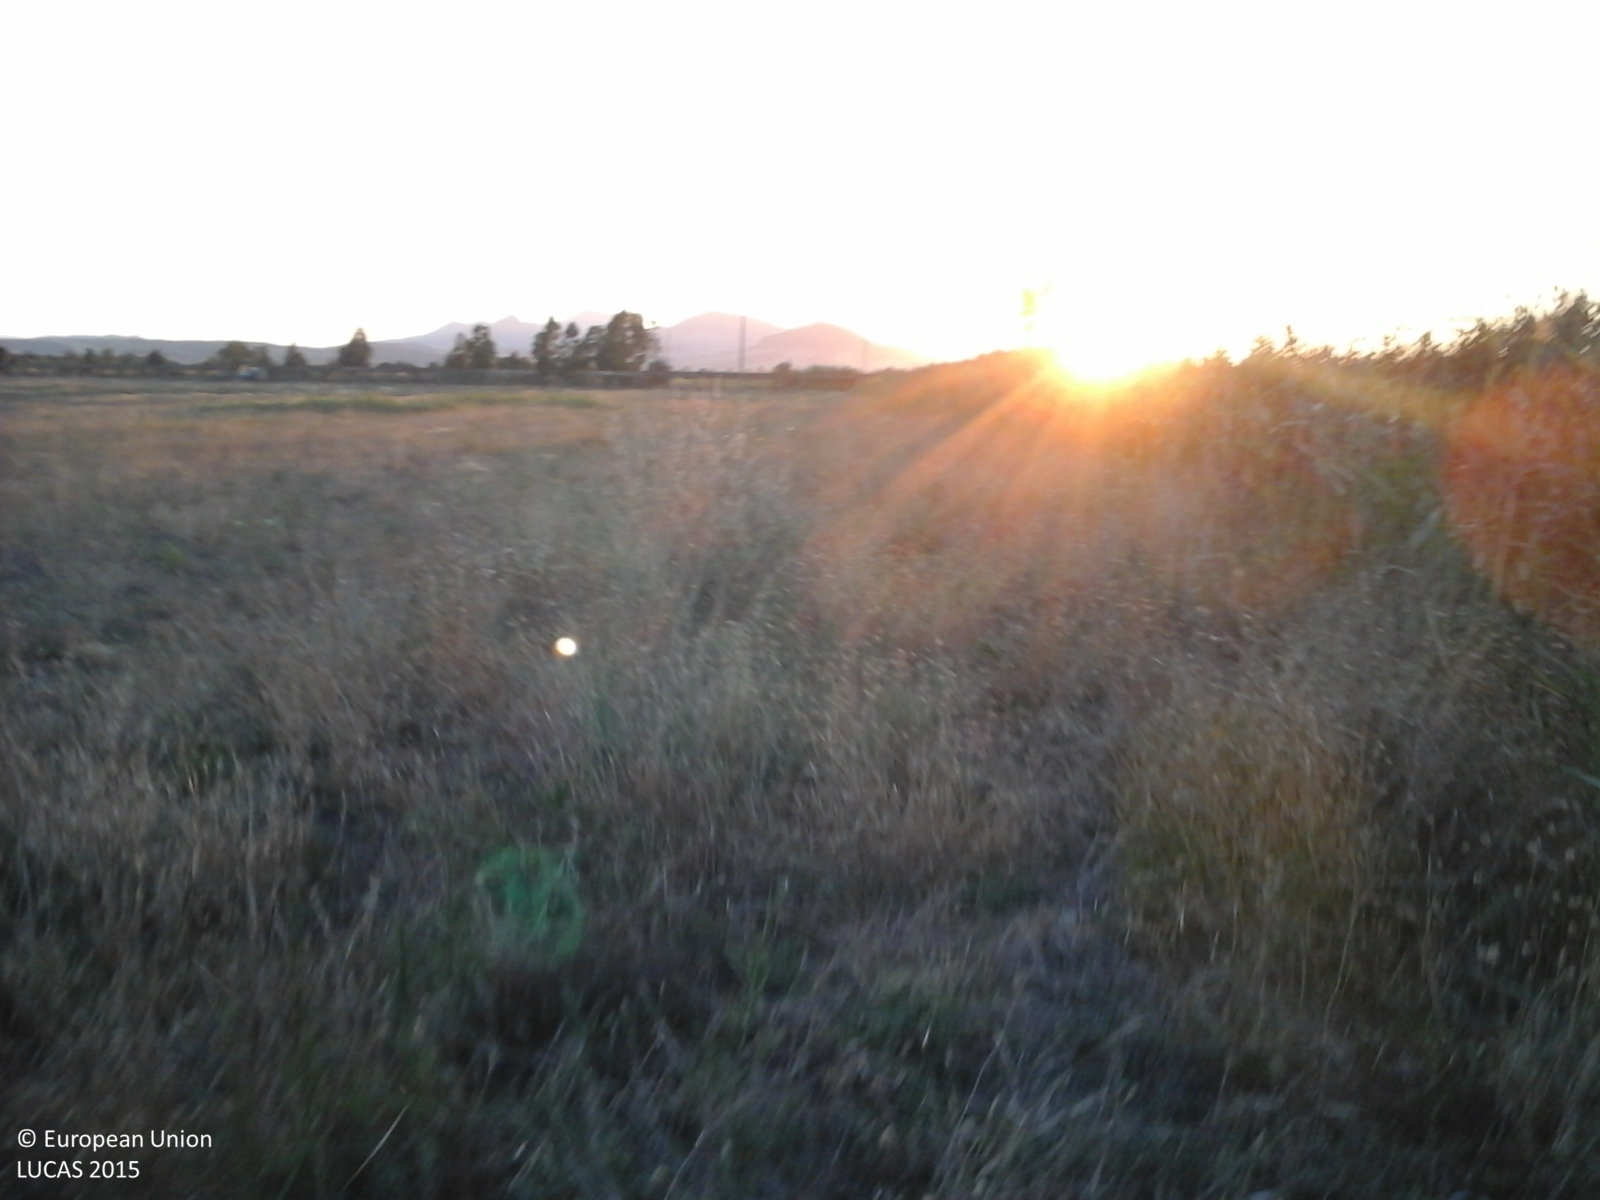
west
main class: Cropland
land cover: Mixed cereals for fodder
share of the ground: > 75 %
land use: Agriculture (excluding fallow land and kitchen gardens)
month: June
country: IT
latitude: 37.4800
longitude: 14.8163
